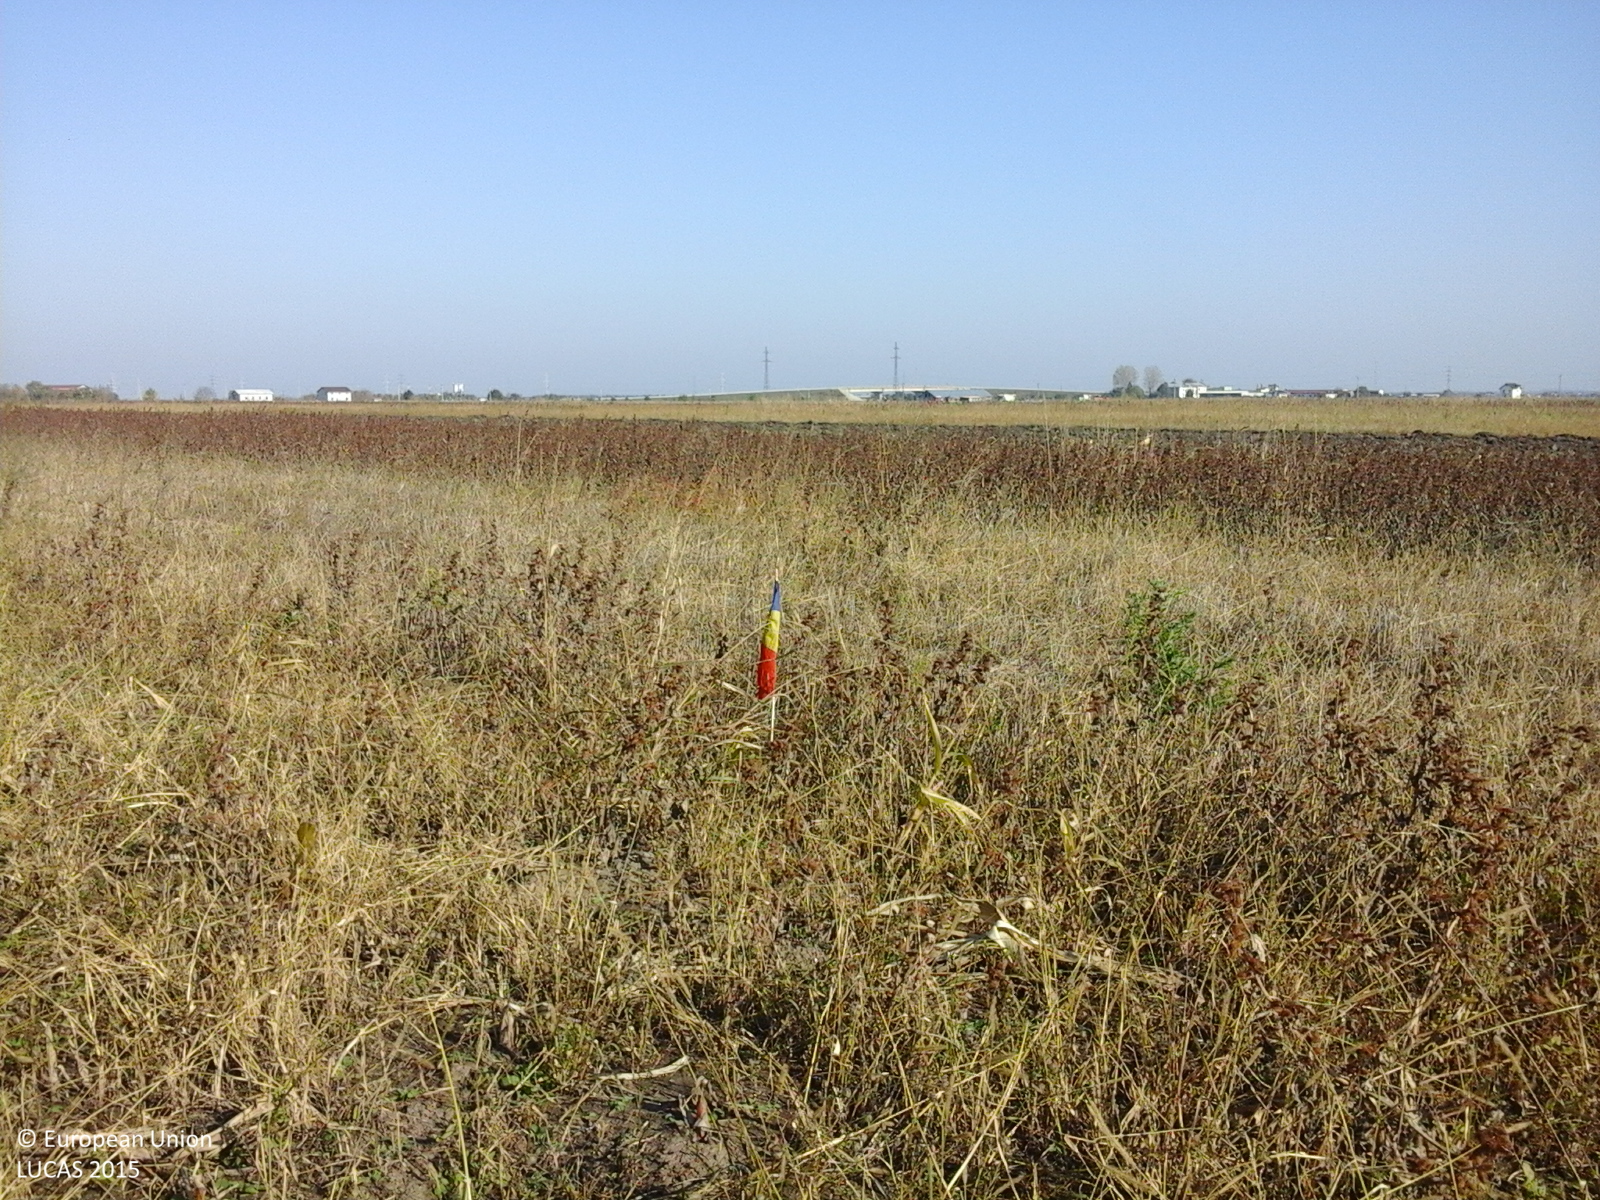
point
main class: Cropland
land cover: Maize
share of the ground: 25 - 50 %
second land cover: Spontaneously vegetated surfaces
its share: > 75 %
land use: Agriculture (excluding fallow land and kitchen gardens)
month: October
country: RO
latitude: 45.7263
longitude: 27.1448
